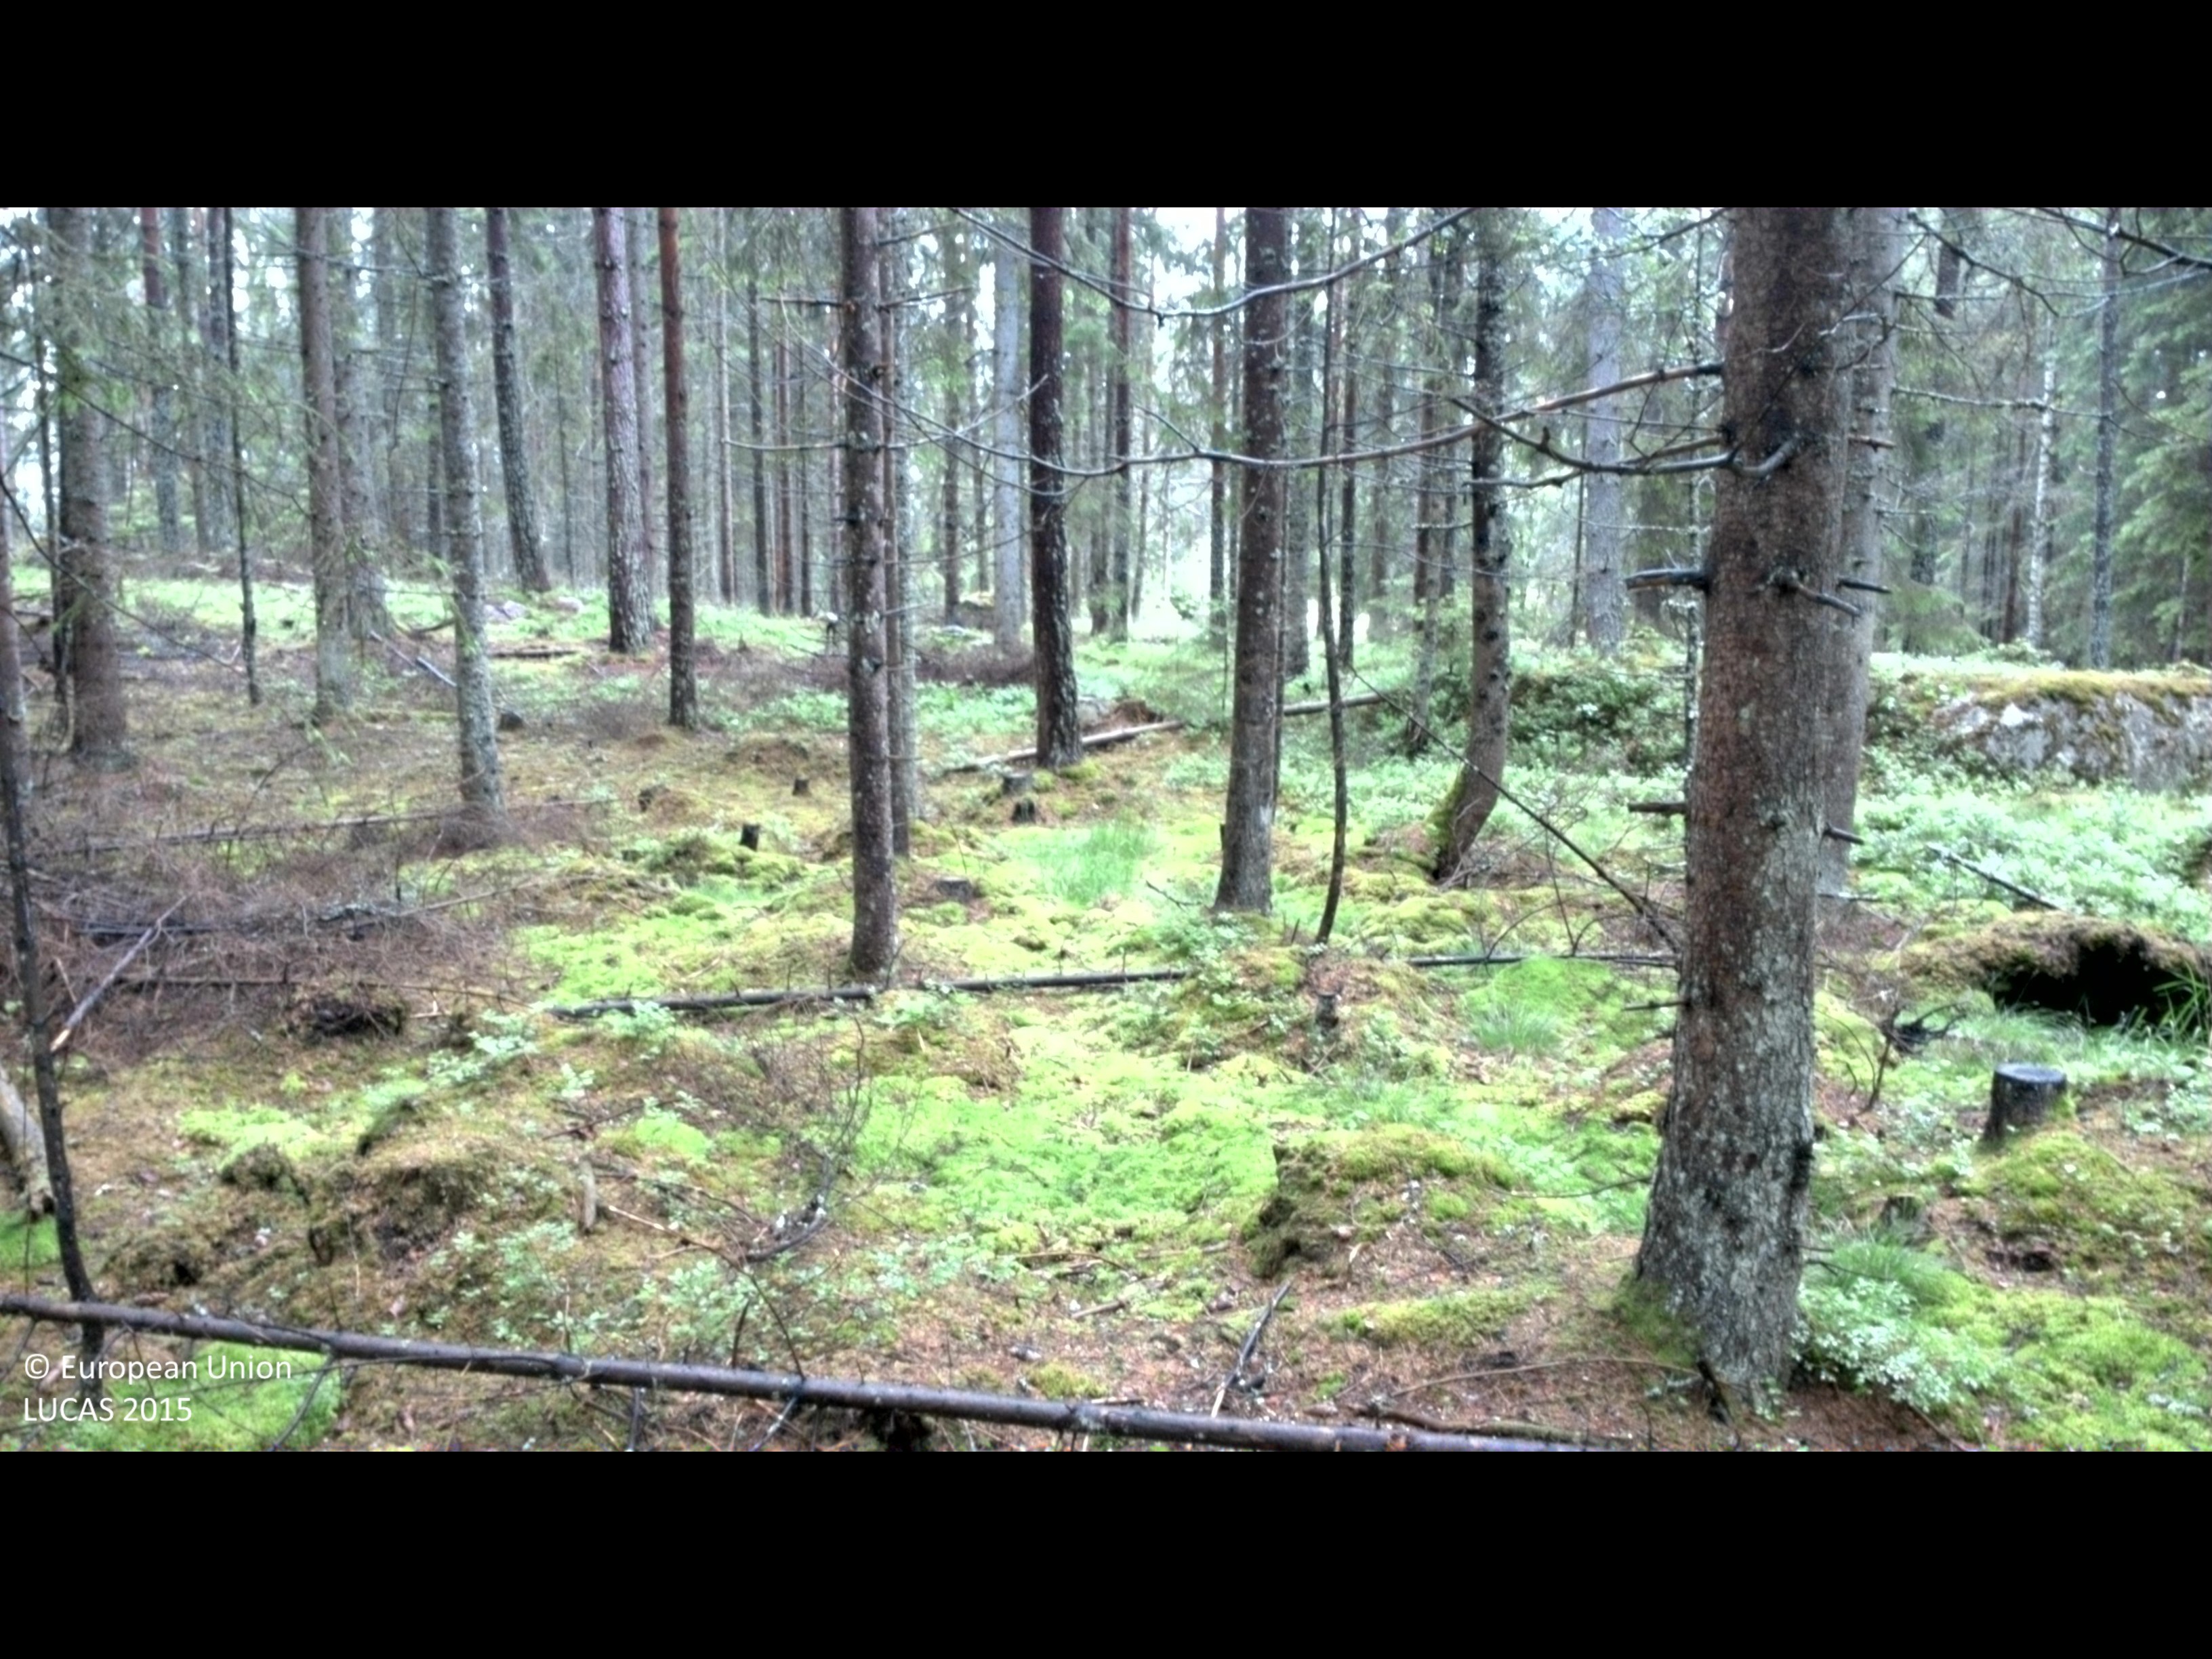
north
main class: Woodland
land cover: Spruce dominated coniferous woodland
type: boreal forest
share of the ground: 50 - 75 %
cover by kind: coniferous forest trees 75 %, shrubs 15 %, lichens and mosses 10 %
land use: Forestry
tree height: > 5 m
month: June
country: SE
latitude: 58.0514
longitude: 16.3510
